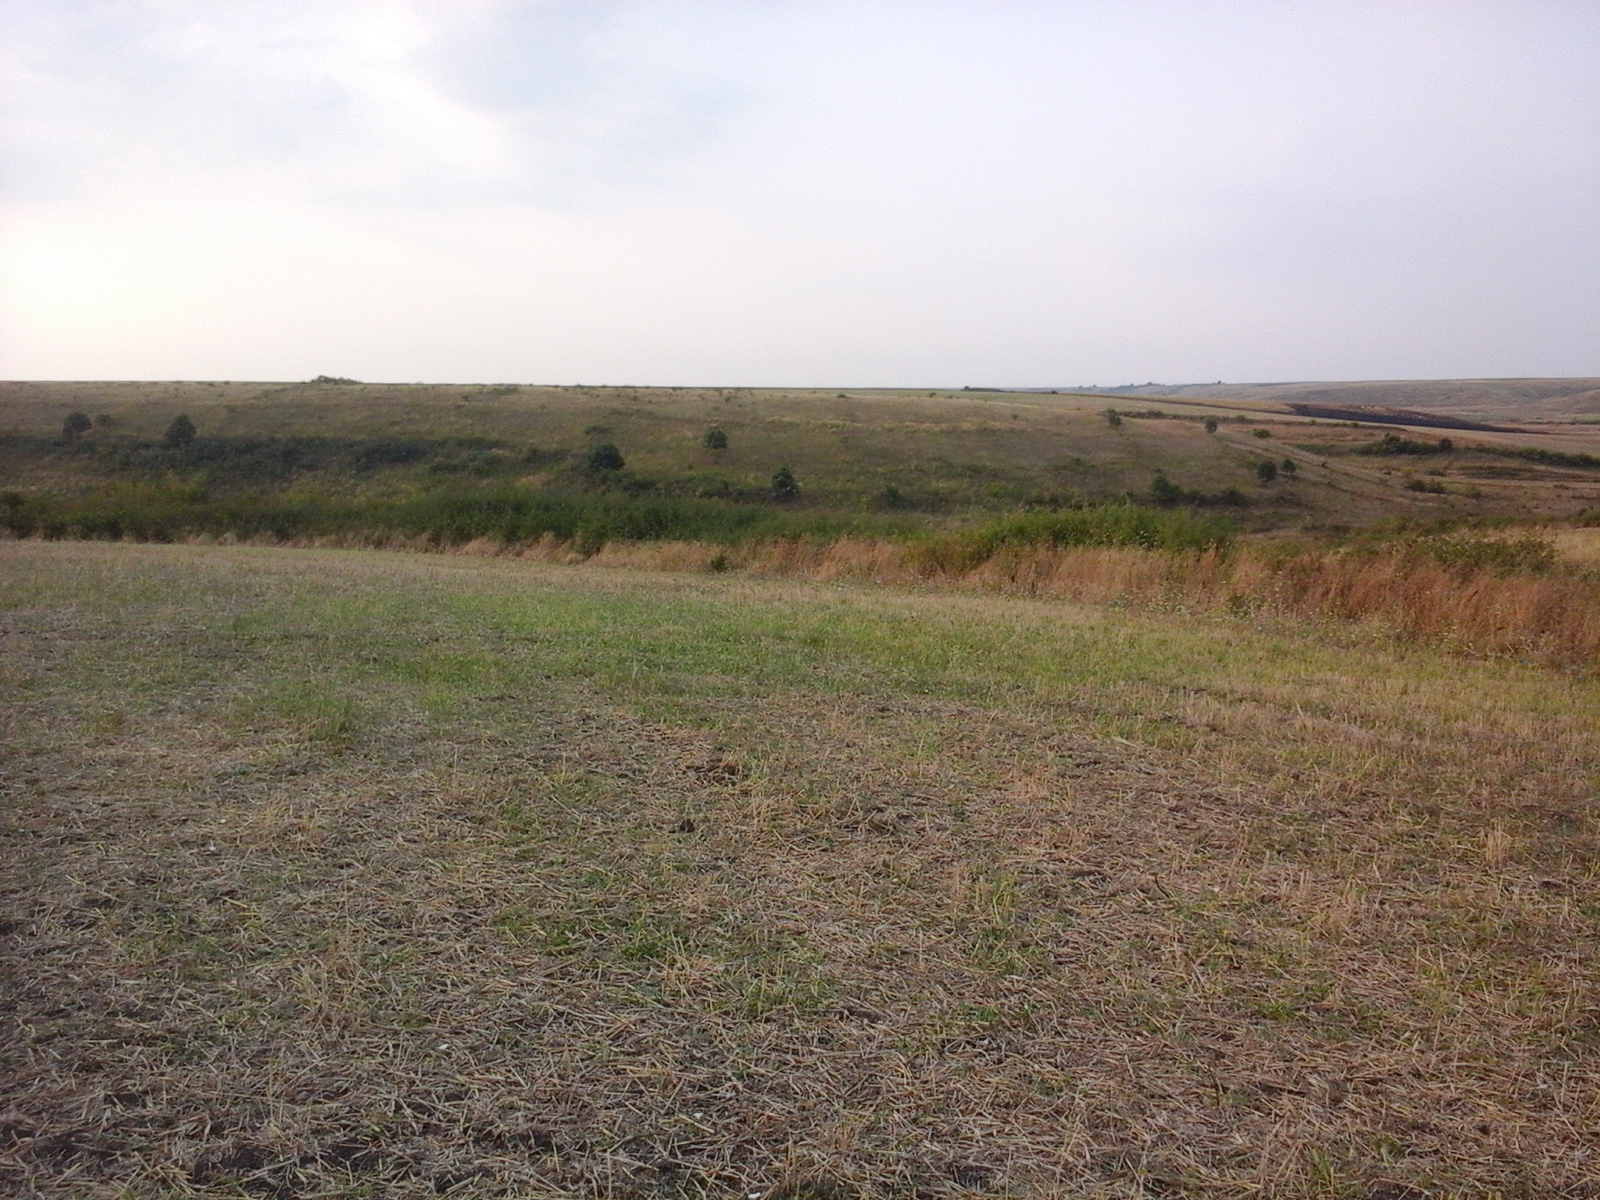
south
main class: Cropland
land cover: Oats
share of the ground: 25 - 50 %
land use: Agriculture (excluding fallow land and kitchen gardens)
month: August
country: RO
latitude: 44.4622
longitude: 23.8213
